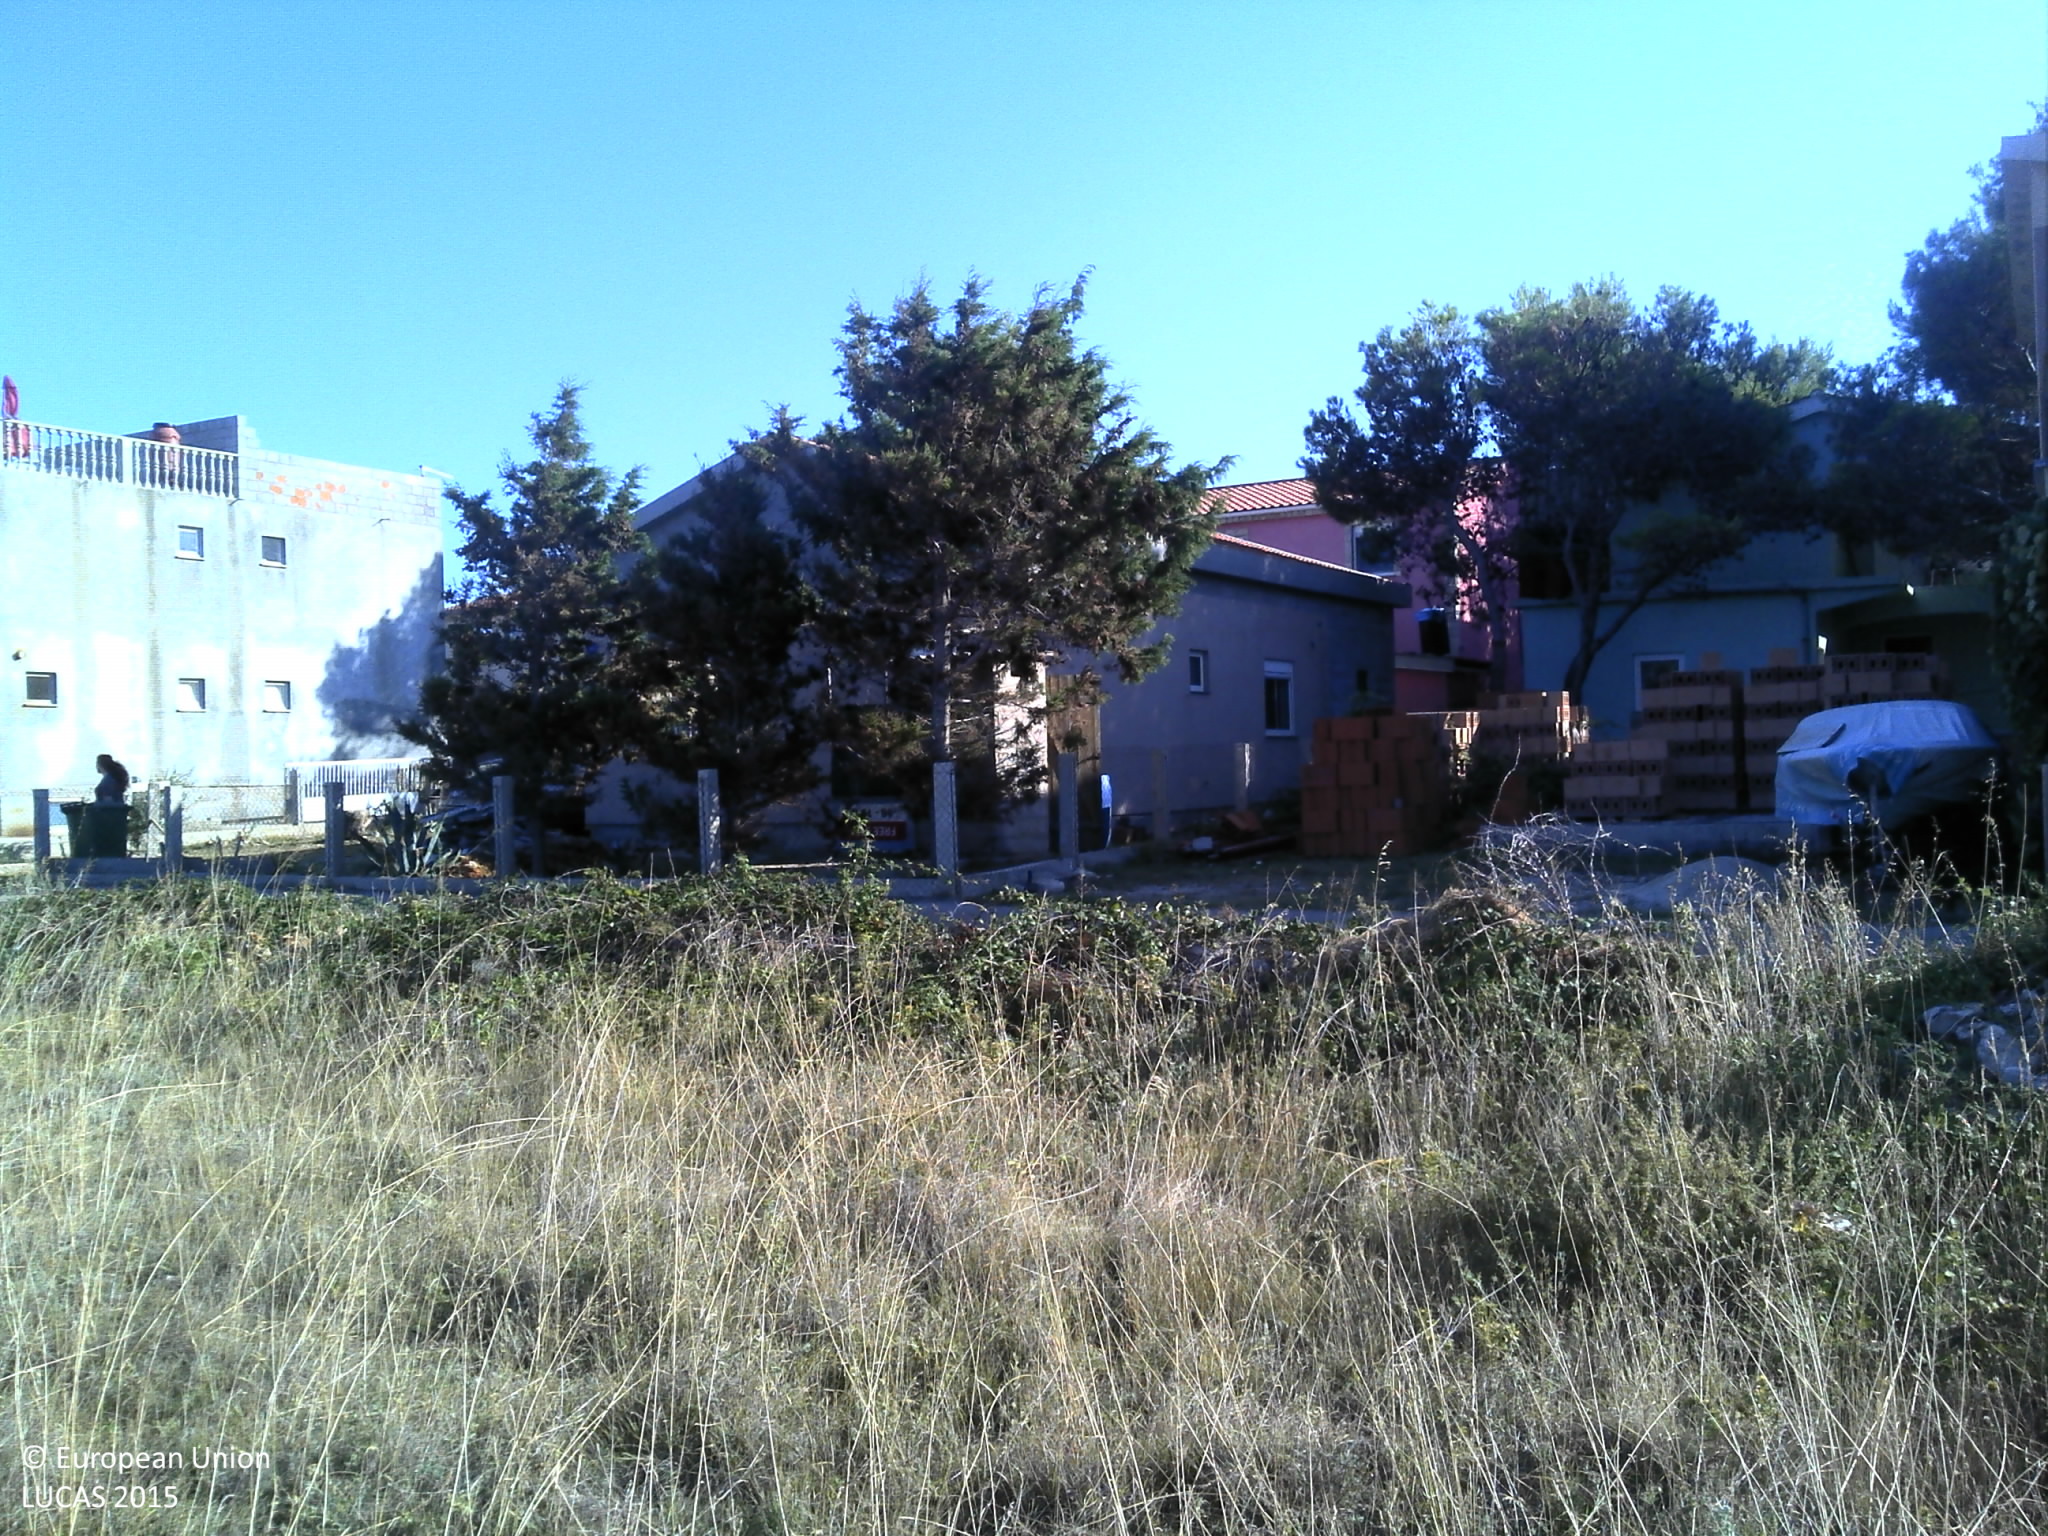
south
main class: Grassland
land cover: Spontaneously vegetated surfaces
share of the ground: > 75 %
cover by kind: herbaceous plants 95 %, unconsolidated bare surface 5 %
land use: Fallow land
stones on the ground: < 10 %
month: July
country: HR
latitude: 44.3170
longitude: 15.0703
